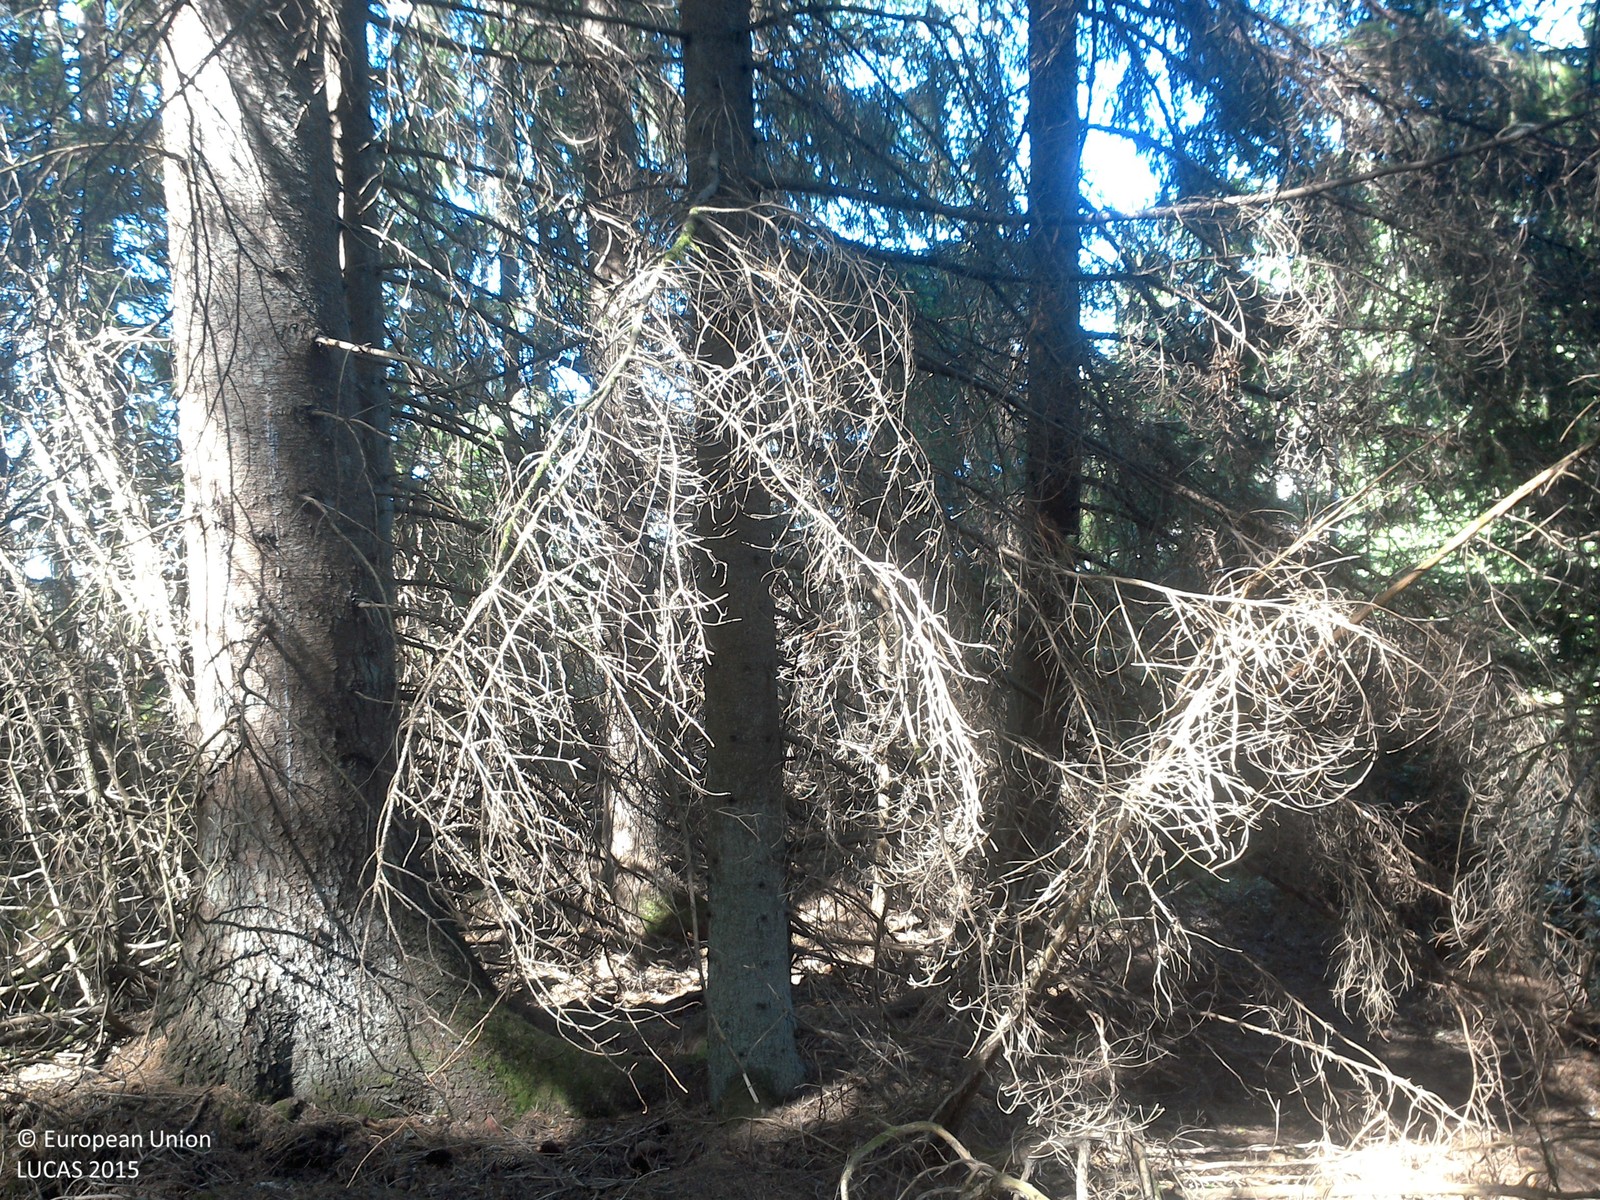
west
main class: Woodland
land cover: Spruce dominated coniferous woodland
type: boreal forest
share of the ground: > 75 %
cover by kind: coniferous forest trees 70 %, lichens and mosses 25 %, broadleaved forest trees 5 %
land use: Forestry
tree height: > 5 m
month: June
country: SE
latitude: 58.3131
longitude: 15.7472
